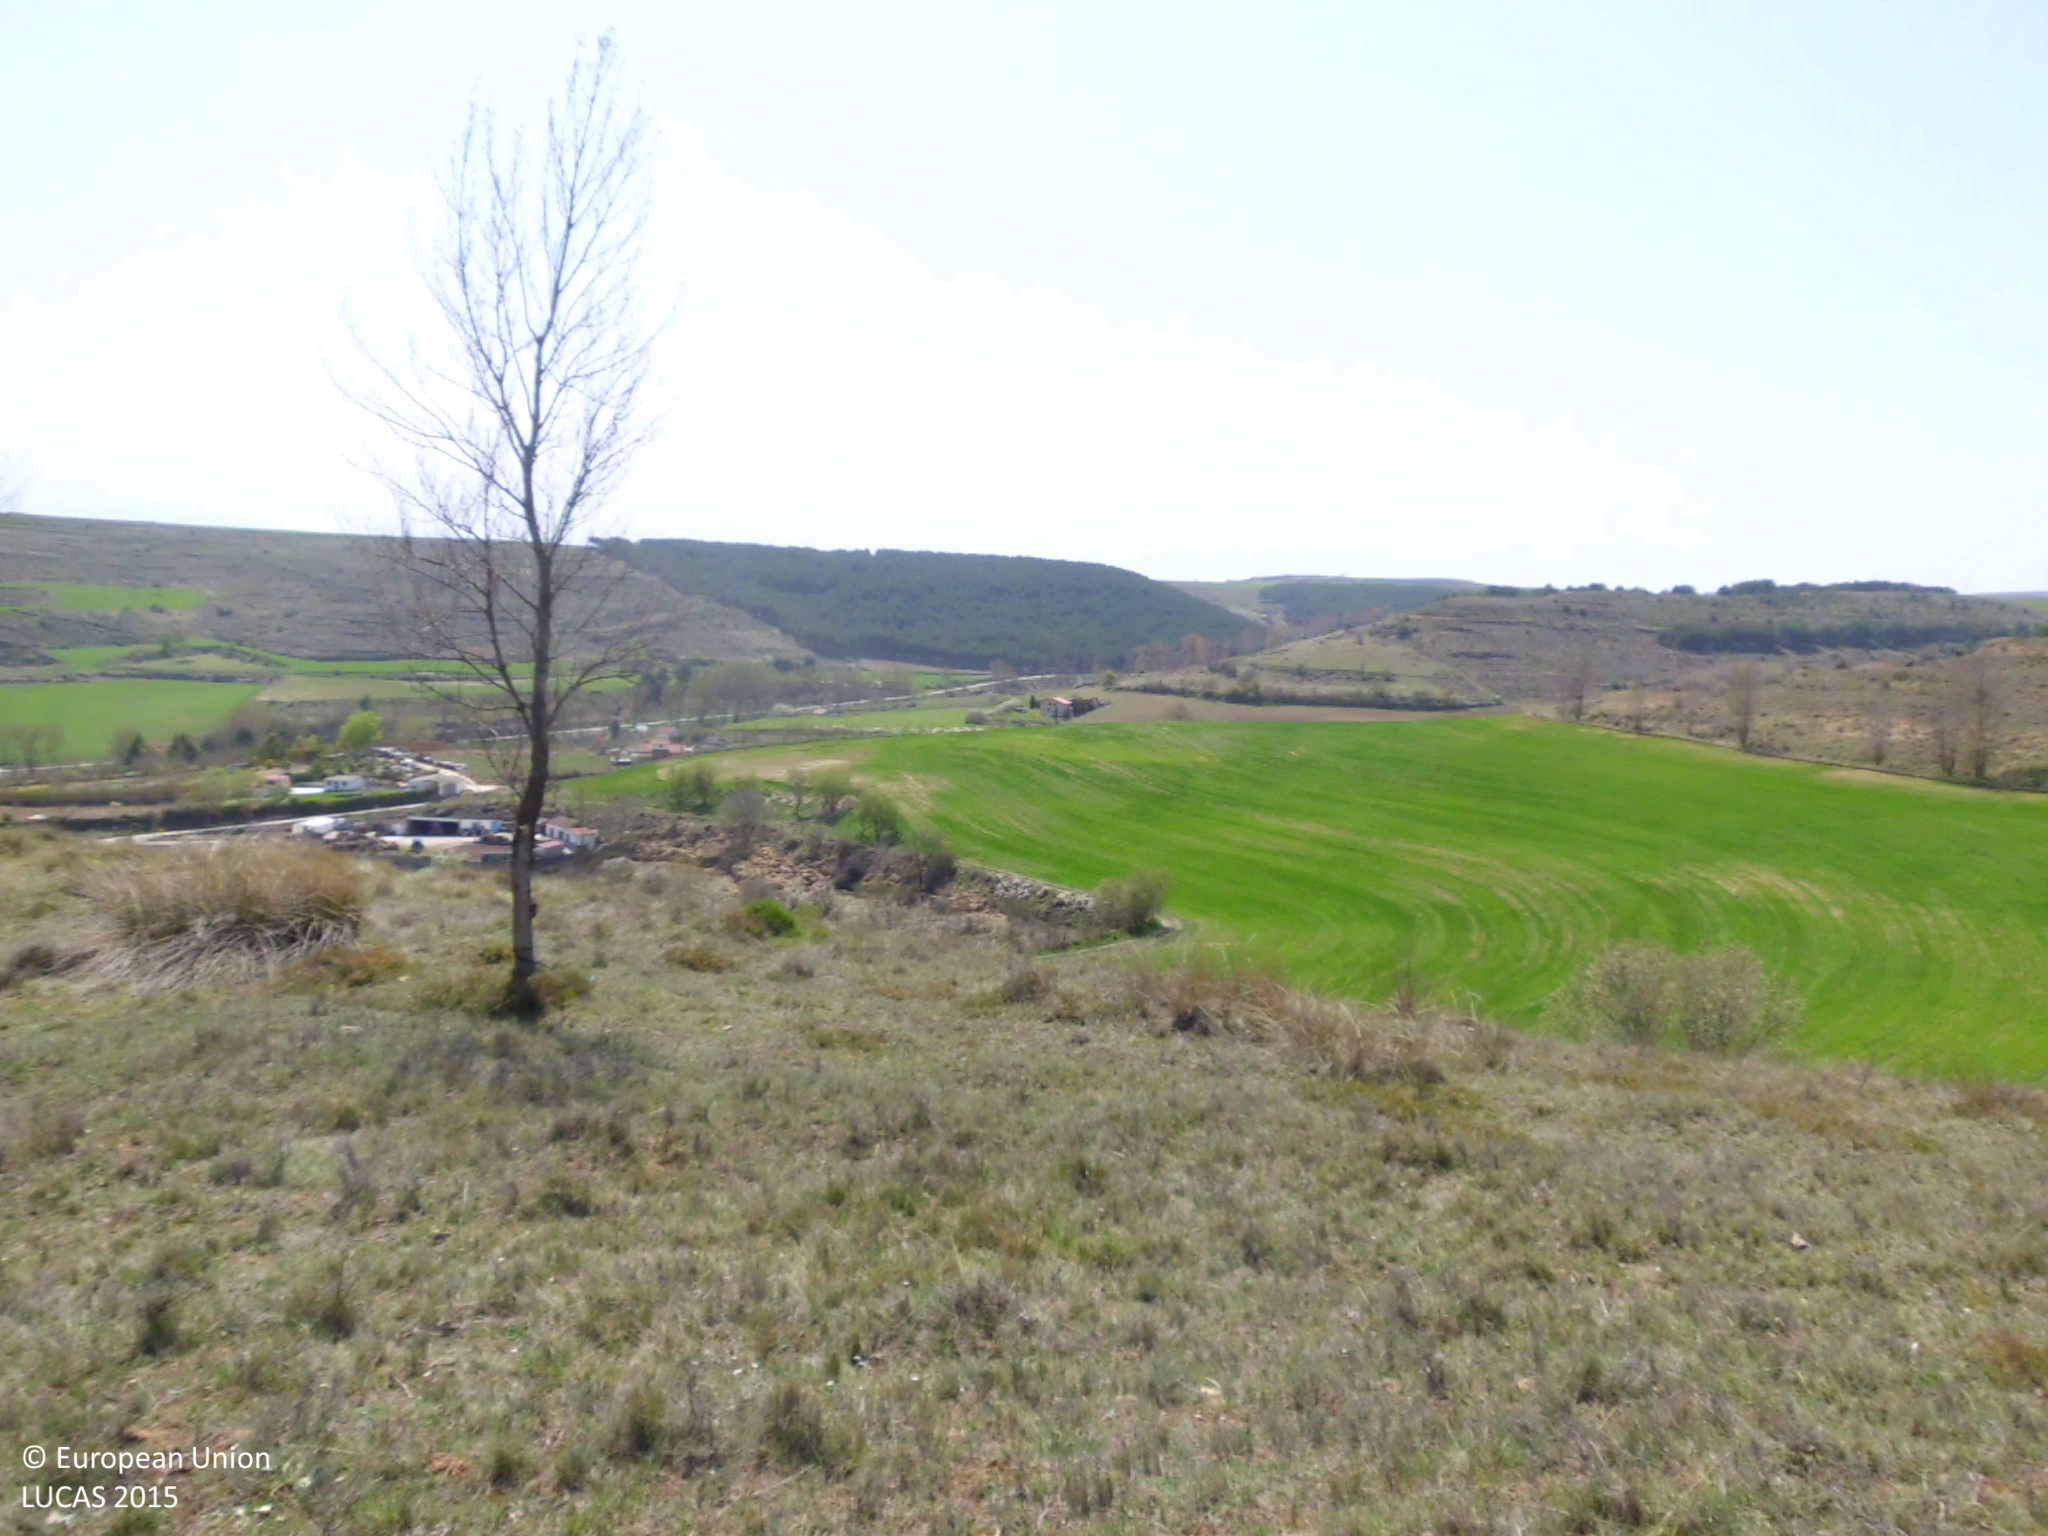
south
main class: Grassland
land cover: Grassland without tree/shrub cover
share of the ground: 50 - 75 %
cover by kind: herbaceous plants 60 %, unconsolidated bare surface 25 %, consolidated bare surface 10 %, shrubs 5 %
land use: Abandoned areas
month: April
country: ES
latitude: 42.5526
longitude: -3.3445
